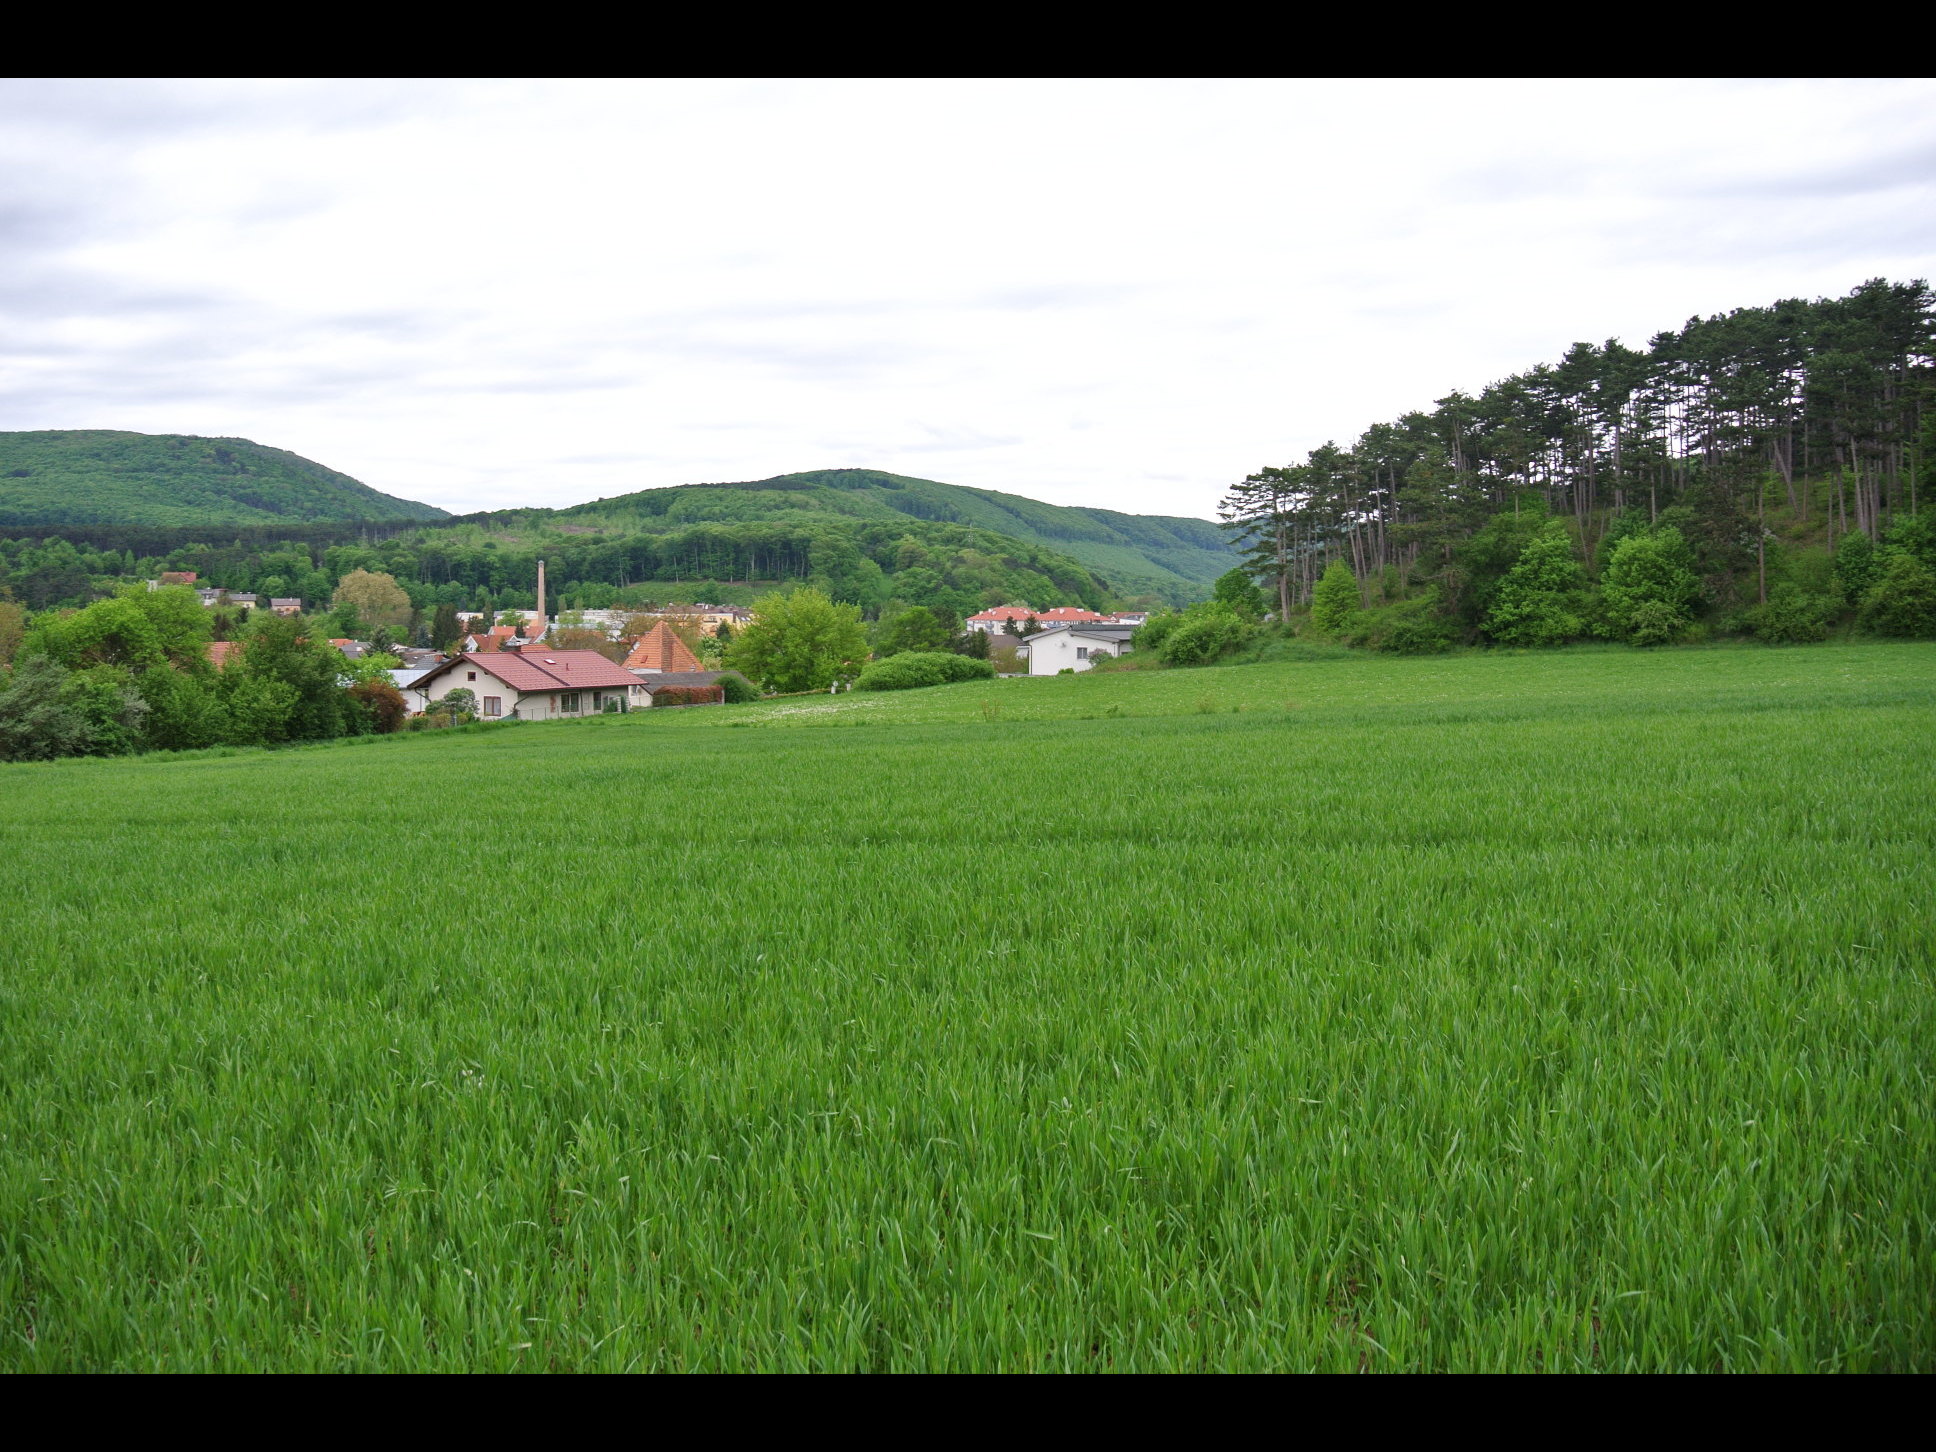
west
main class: Cropland
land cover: Barley
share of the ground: > 75 %
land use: Agriculture (excluding fallow land and kitchen gardens)
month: May
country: AT
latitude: 47.9645
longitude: 16.0976
